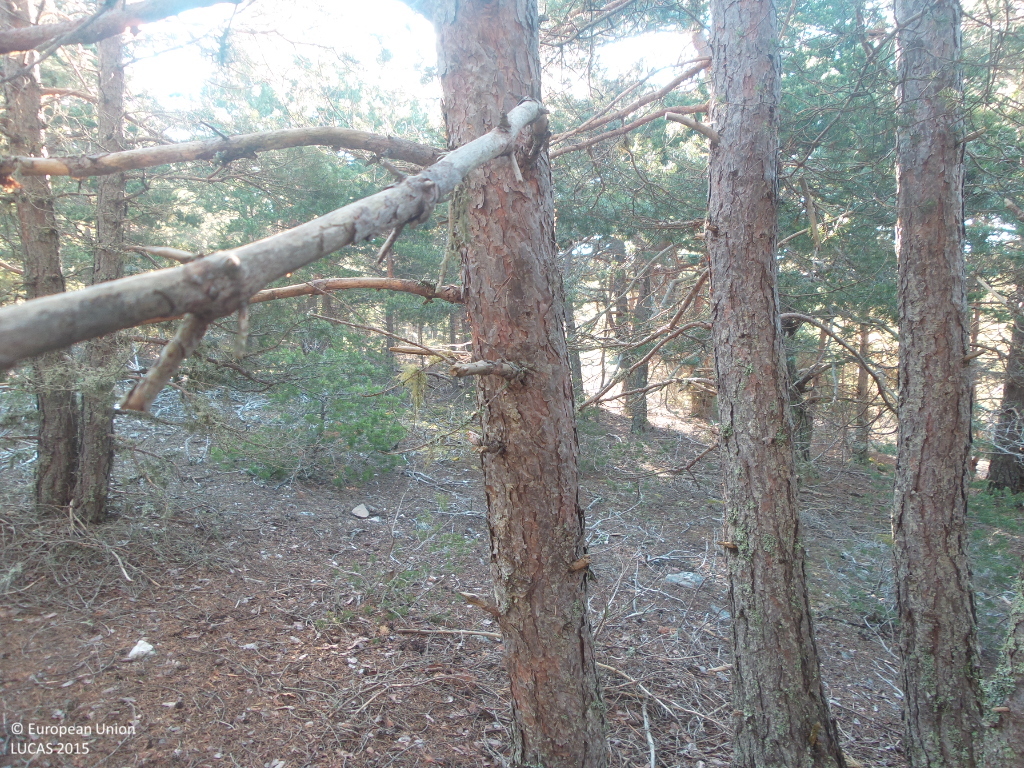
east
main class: Woodland
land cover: Pine dominated coniferous woodland
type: coniferous forest of the mediterranean region
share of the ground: > 75 %
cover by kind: coniferous forest trees 85 %, shrubs 5 %, lichens and mosses 5 %, unconsolidated bare surface 5 %
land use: Forestry
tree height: > 5 m
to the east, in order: Pine dominated coniferous woodland
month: June
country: ES
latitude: 41.1965
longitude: -3.0960
